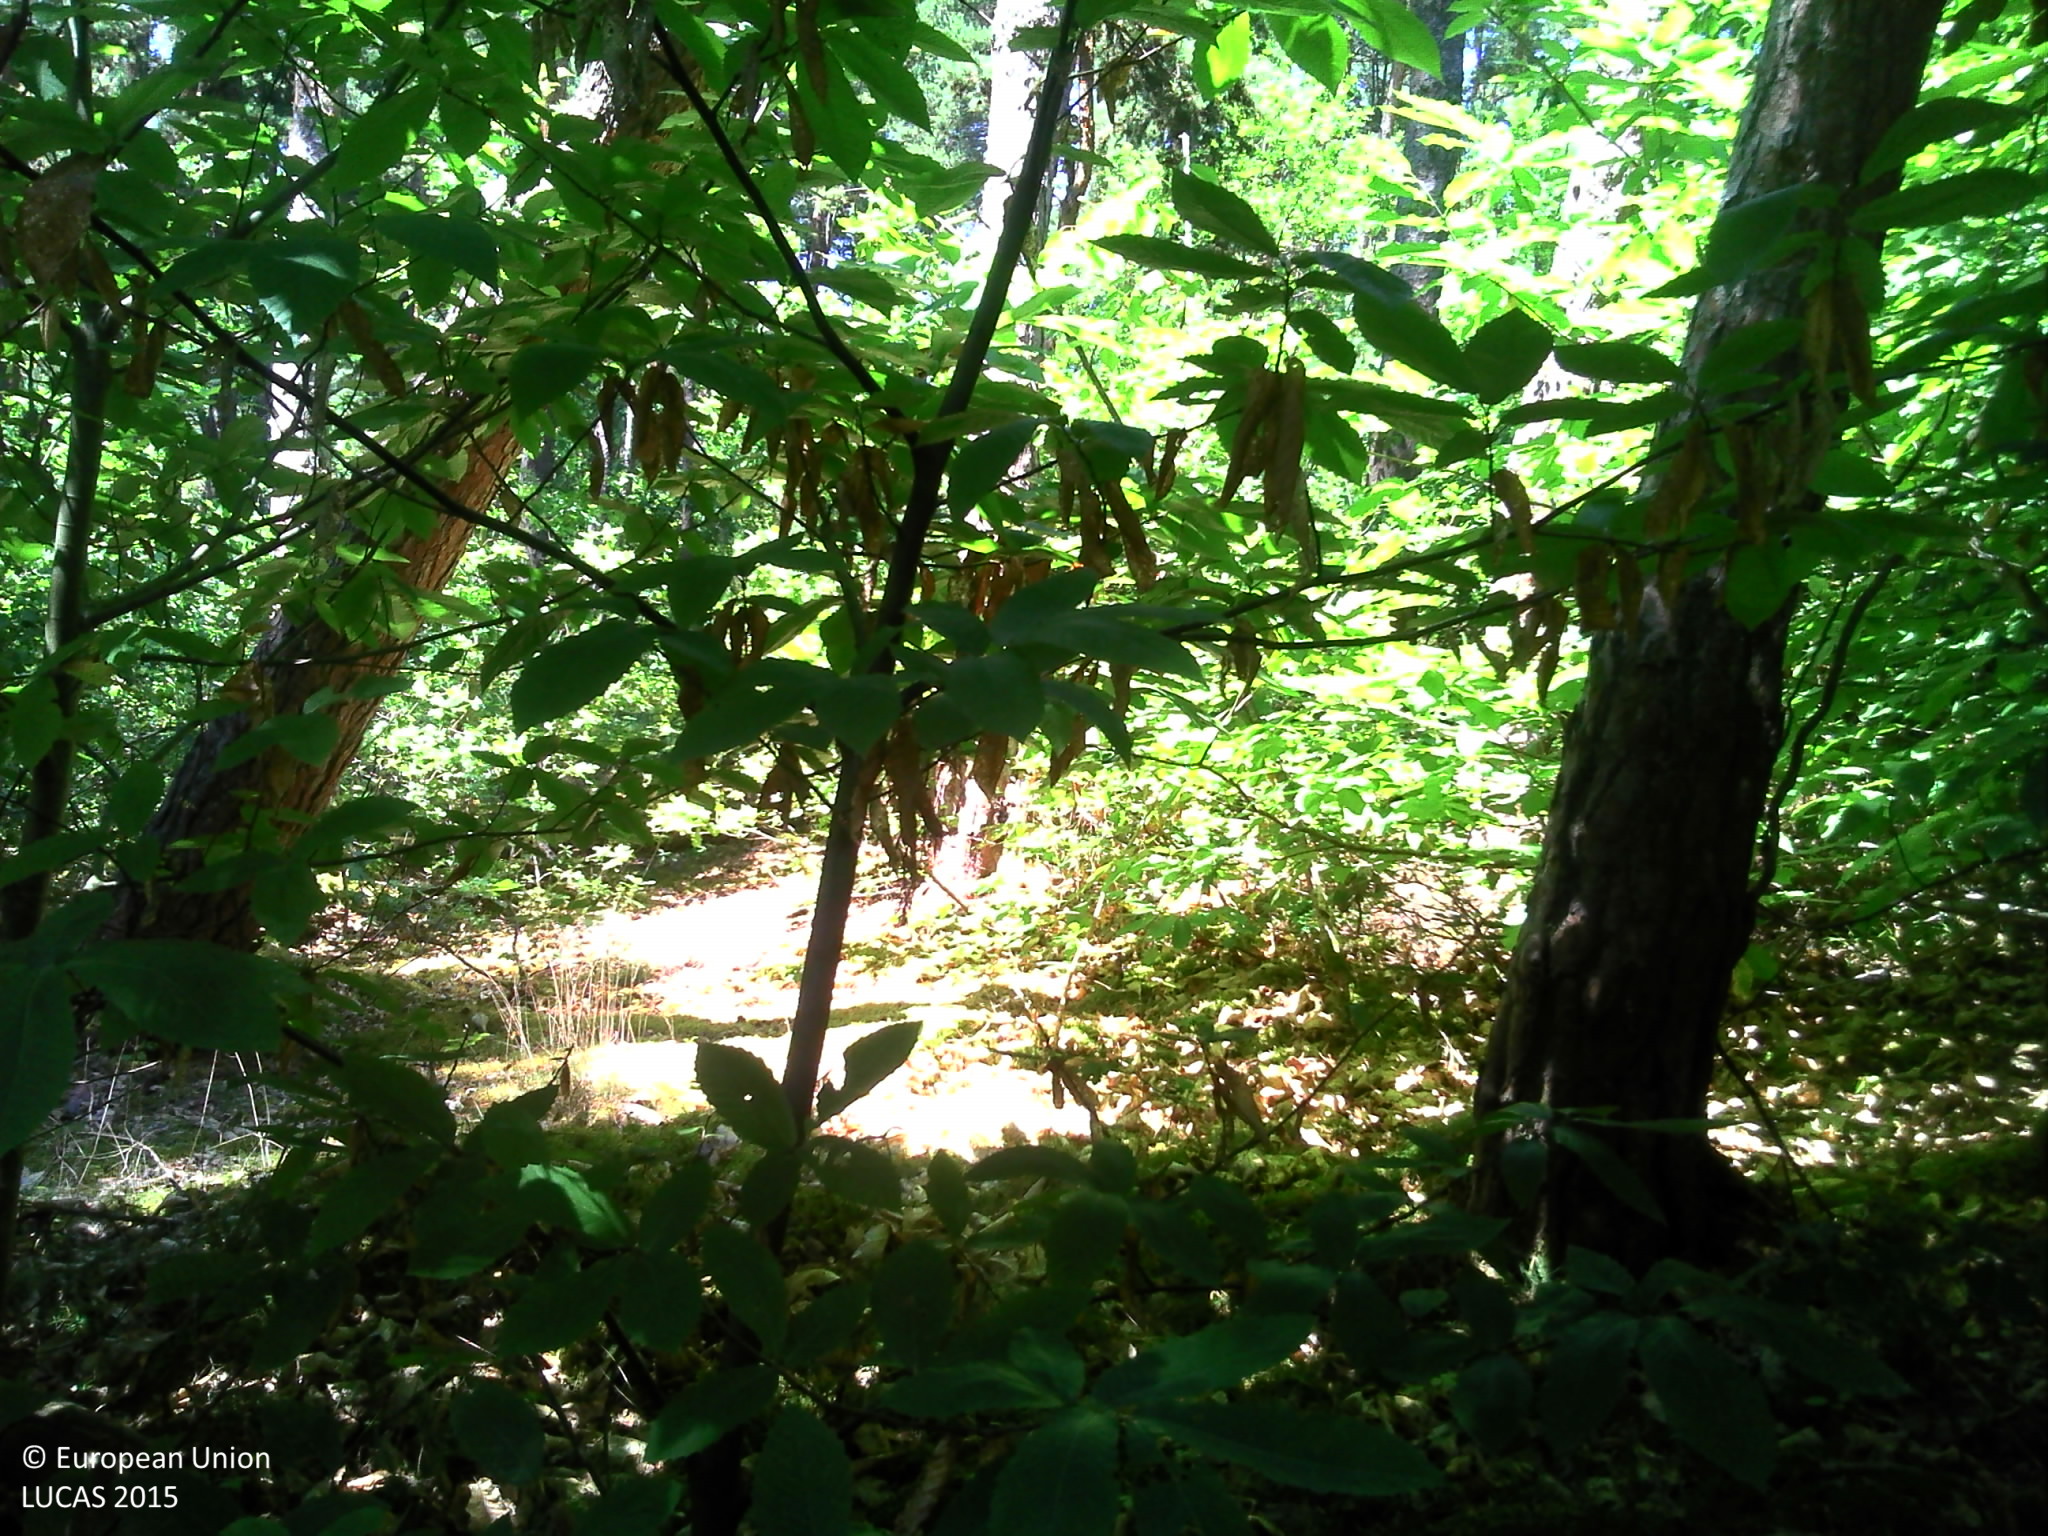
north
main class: Woodland
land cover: Pine dominated mixed woodland
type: hemiboreal forest and nemoral coniferous forest and mixed broadleaved-coniferous forest
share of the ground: > 75 %
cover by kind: coniferous forest trees 75 %, broadleaved forest trees 25 %
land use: Forestry
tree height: > 5 m
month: July
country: FR
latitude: 45.3195
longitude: 3.4580
